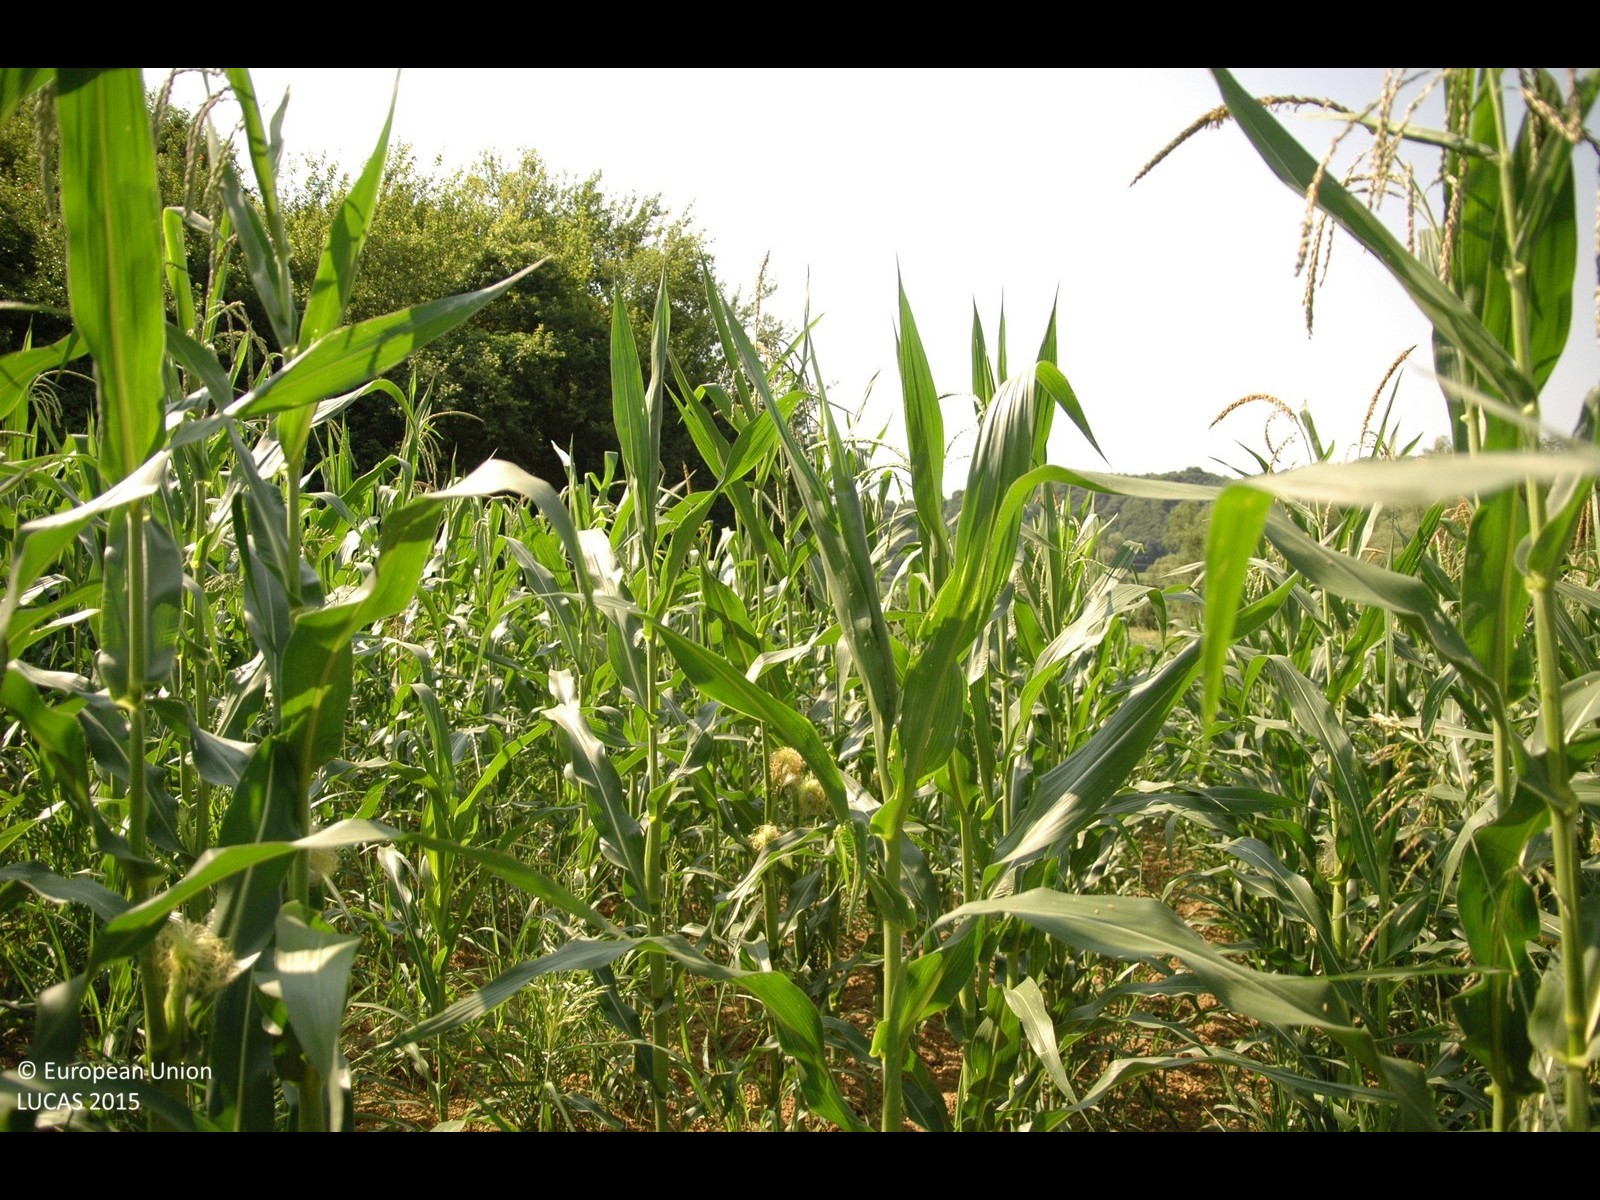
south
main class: Cropland
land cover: Maize
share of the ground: > 75 %
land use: Agriculture (excluding fallow land and kitchen gardens)
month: July
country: HR
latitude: 46.1097
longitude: 16.0149
